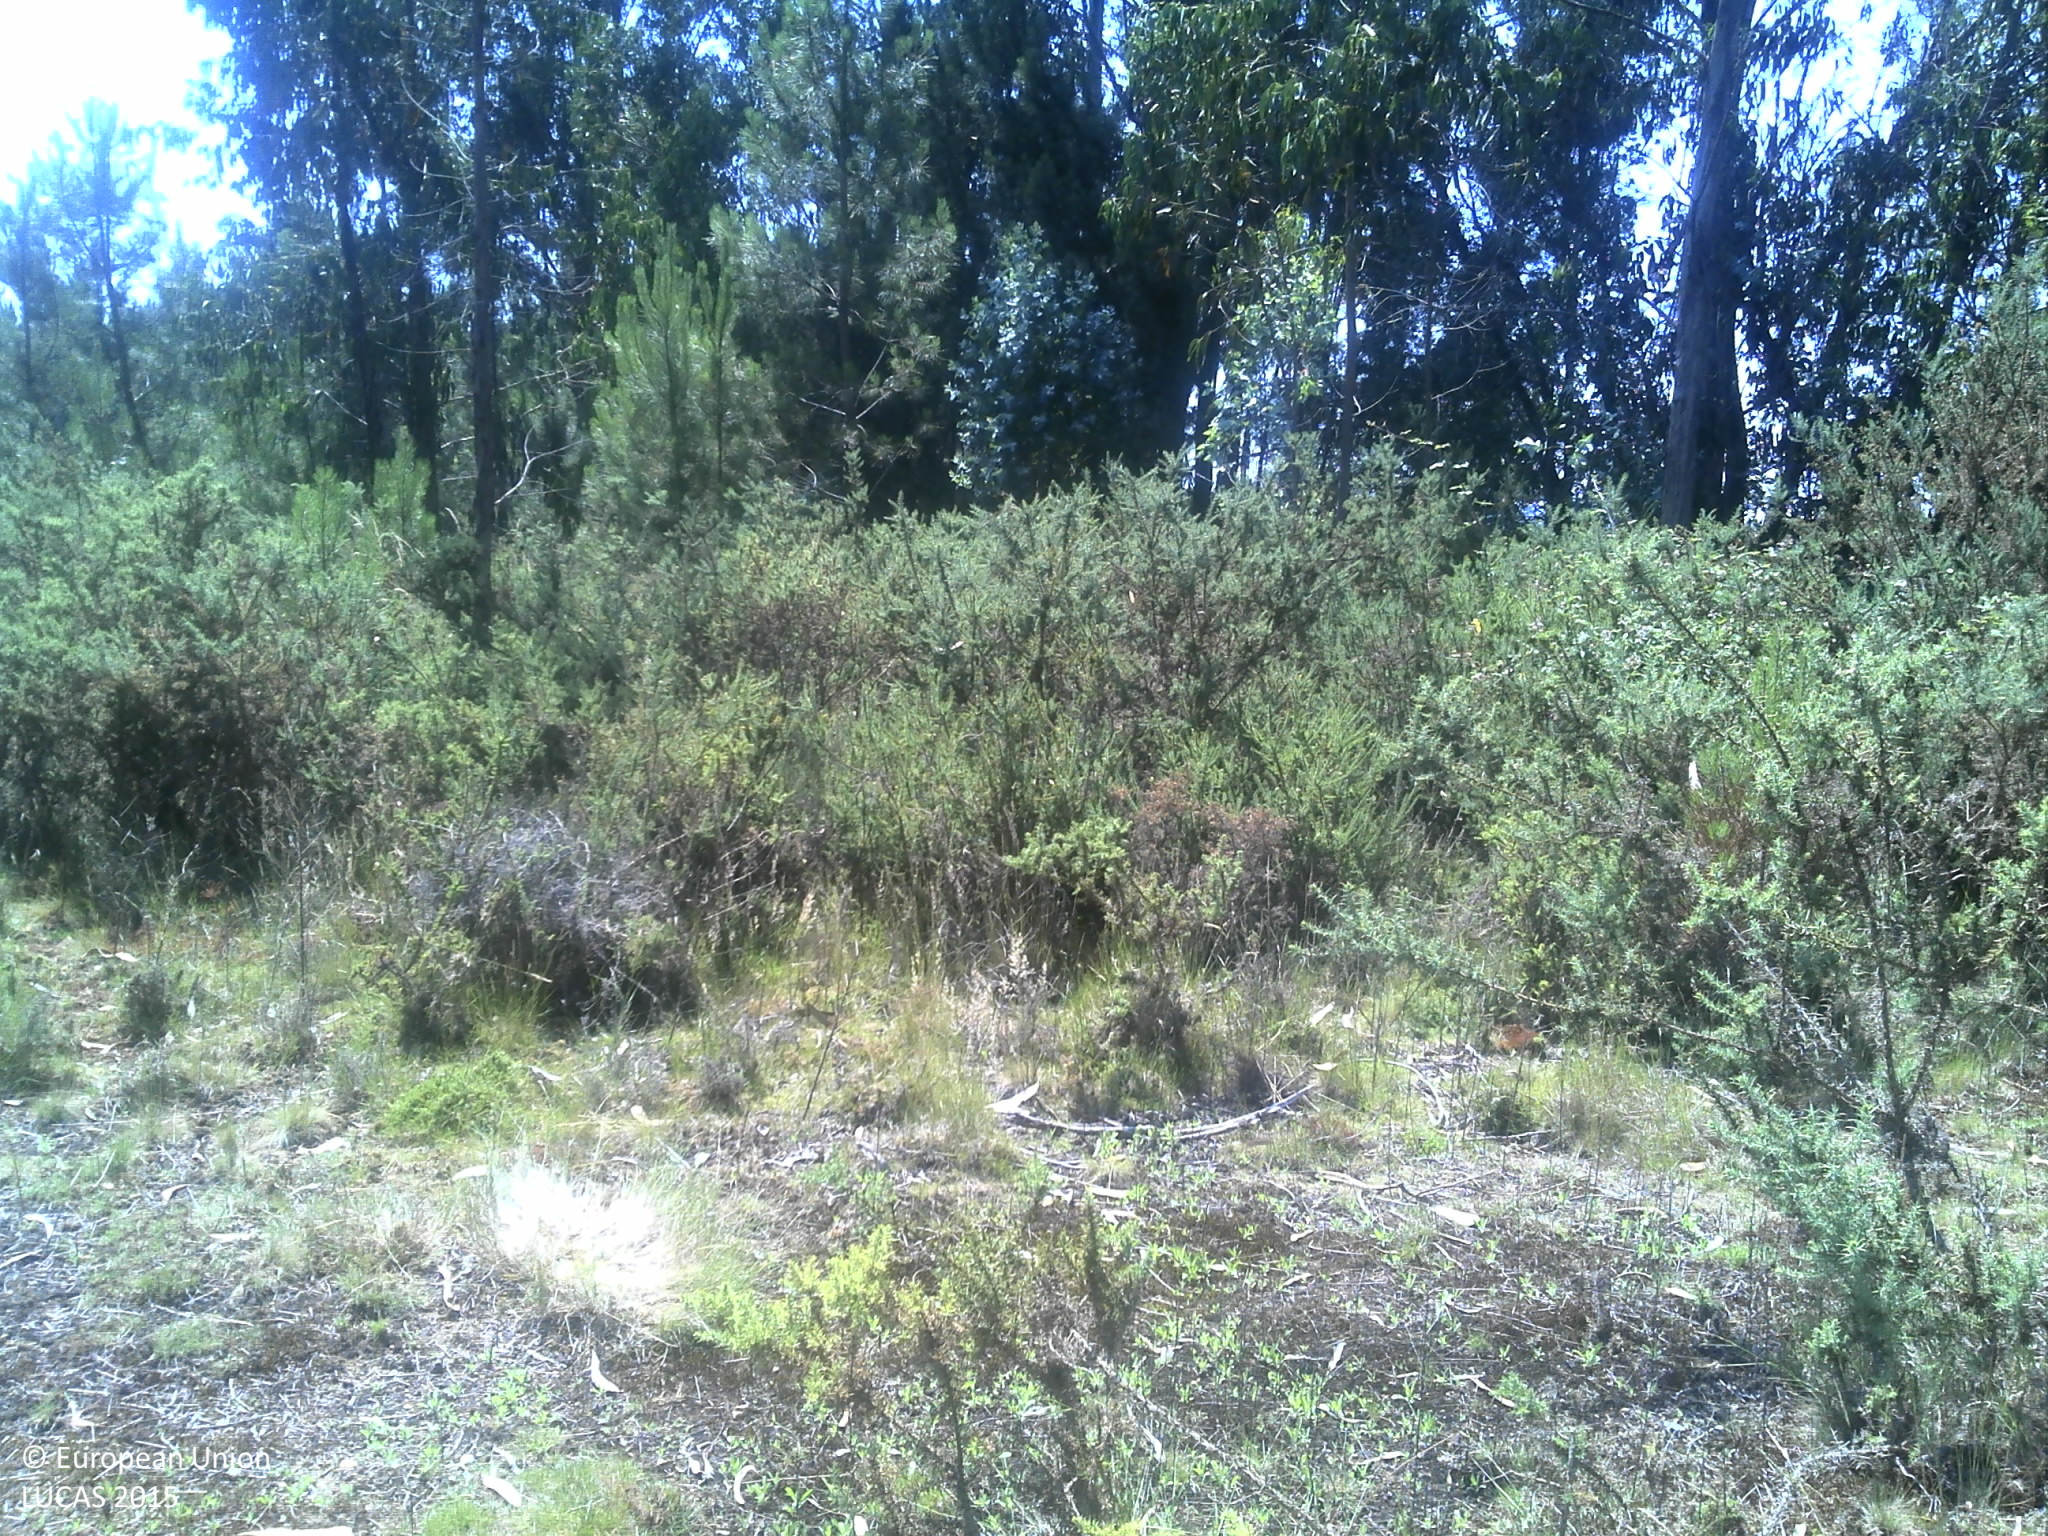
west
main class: Shrubland
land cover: Shrubland with sparse tree cover
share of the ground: > 75 %
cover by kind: shrubs 85 %, herbaceous plants 10 %, coniferous forest trees 5 %
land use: Semi-natural and natural areas not in use
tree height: > 5 m
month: June
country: PT
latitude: 41.5272
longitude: -8.5782
